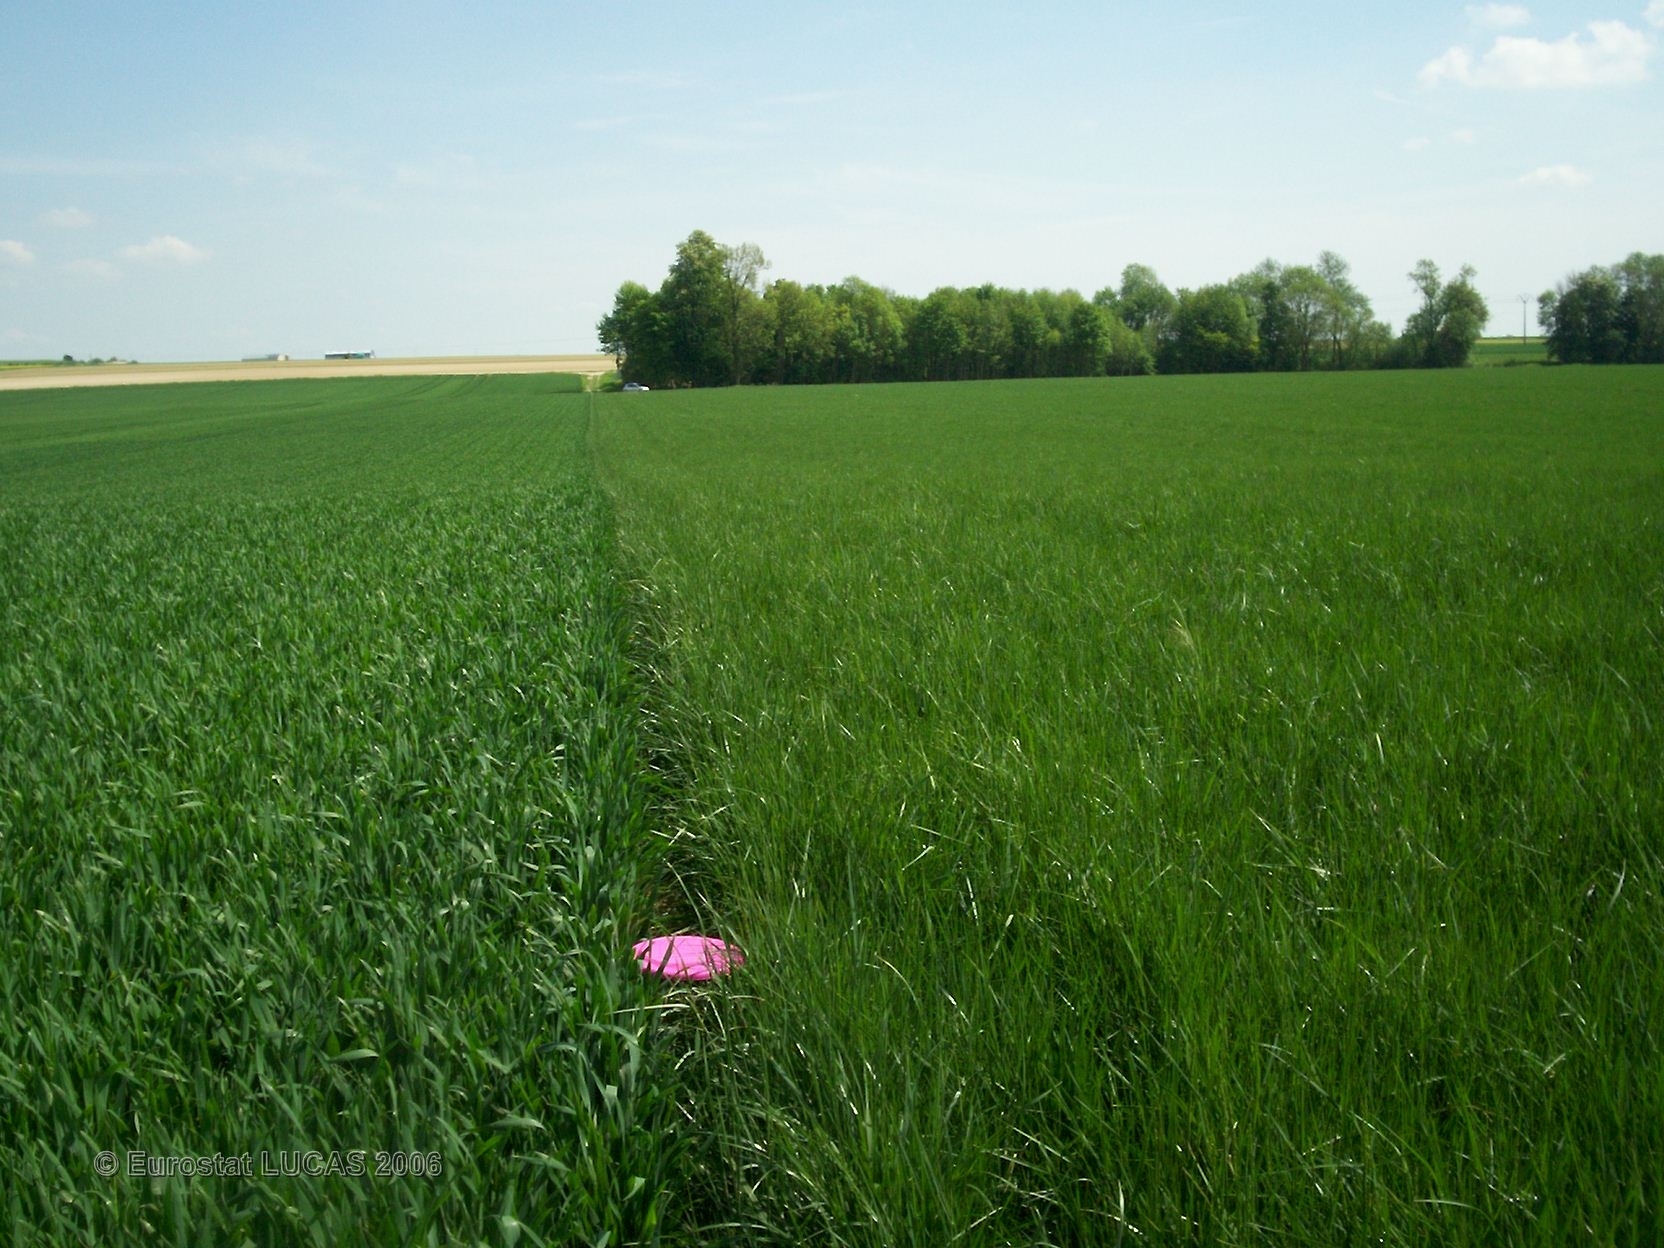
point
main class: Cropland
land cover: Common wheat
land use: Agriculture (excluding fallow land and kitchen gardens)
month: May
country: FR
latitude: 48.9130
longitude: 4.4431
